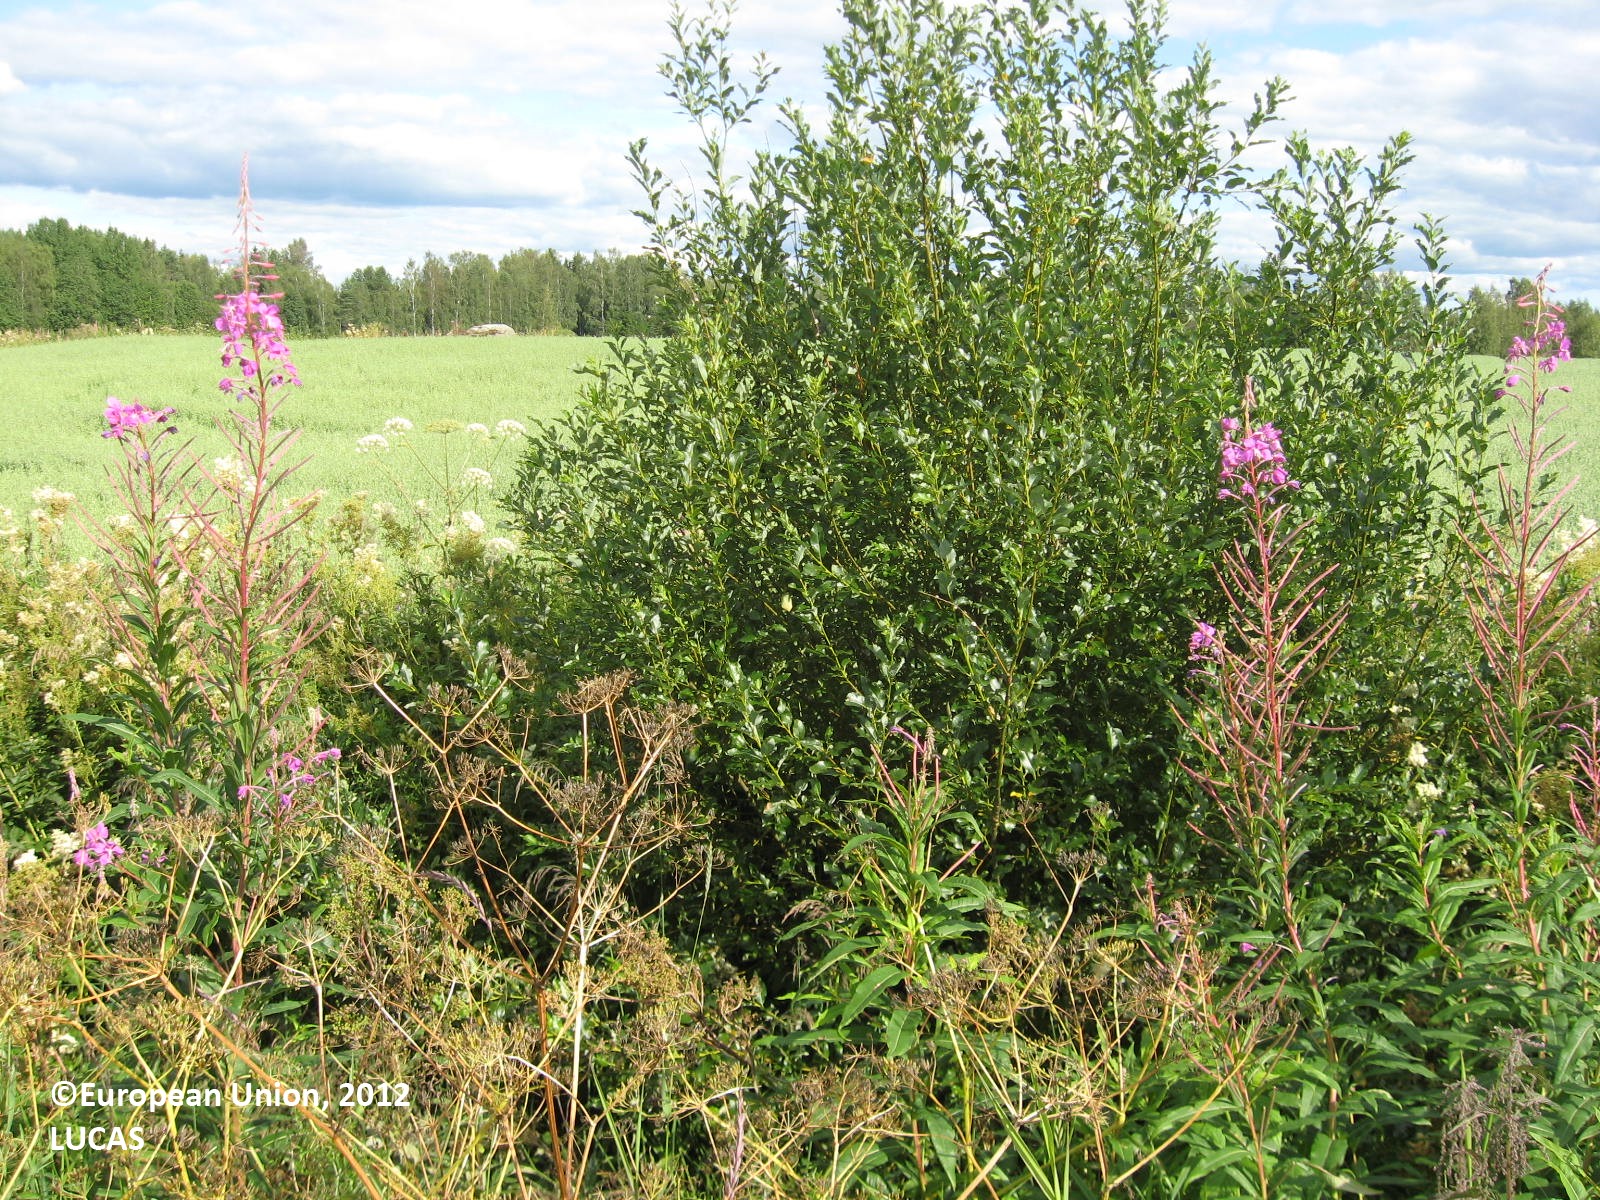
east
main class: Cropland
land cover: Oats
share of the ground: > 75 %
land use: Agriculture (excluding fallow land and kitchen gardens)
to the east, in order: Oats; Shruby margins; Ditches and canals; Shruby margins; Oats; Grass margins; Rocks and stones; Shruby margins; Grass margins; Paved roads, cycling and walking lanes; Grass margins; Shruby margins; Ditches and canals; Shruby margins; Oats; Shruby margins; Ditches and canals; Shruby margins; Oats
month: July
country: FI
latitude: 61.9997
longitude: 22.2572
